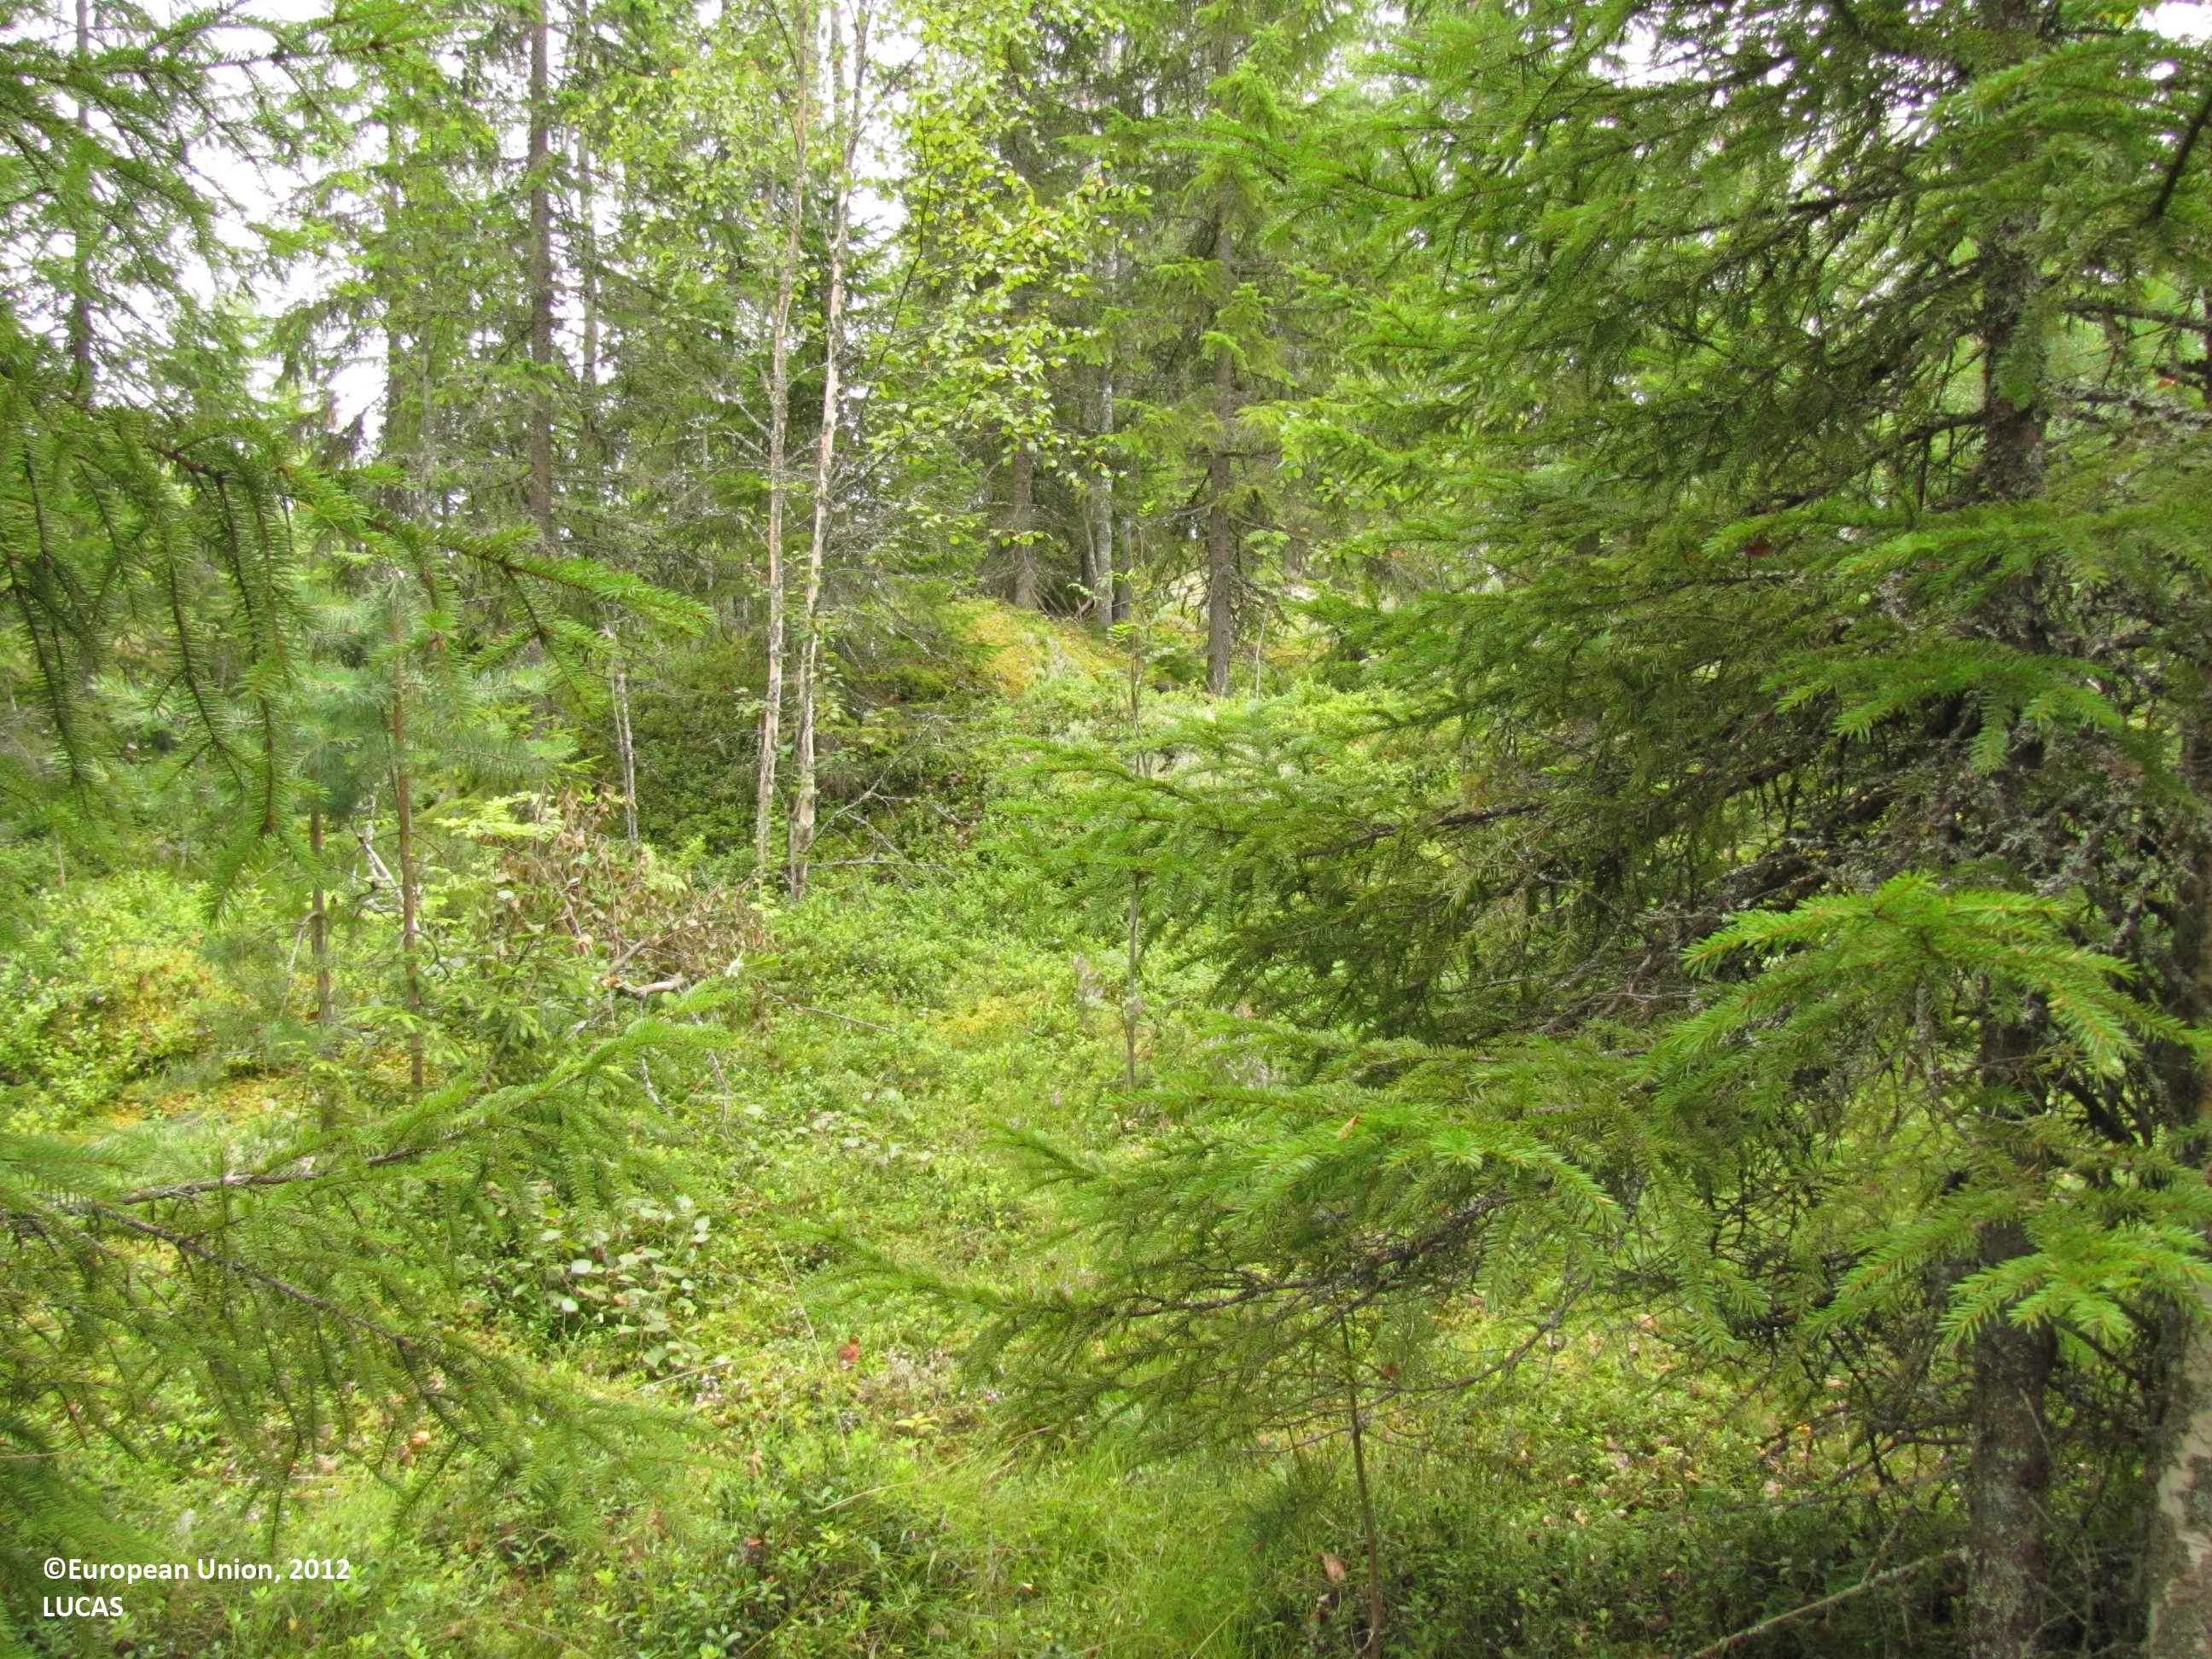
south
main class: Woodland
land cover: Spruce dominated coniferous woodland
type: boreal forest
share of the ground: 50 - 75 %
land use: Forestry
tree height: > 5 m
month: August
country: FI
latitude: 61.9321
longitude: 23.0424
